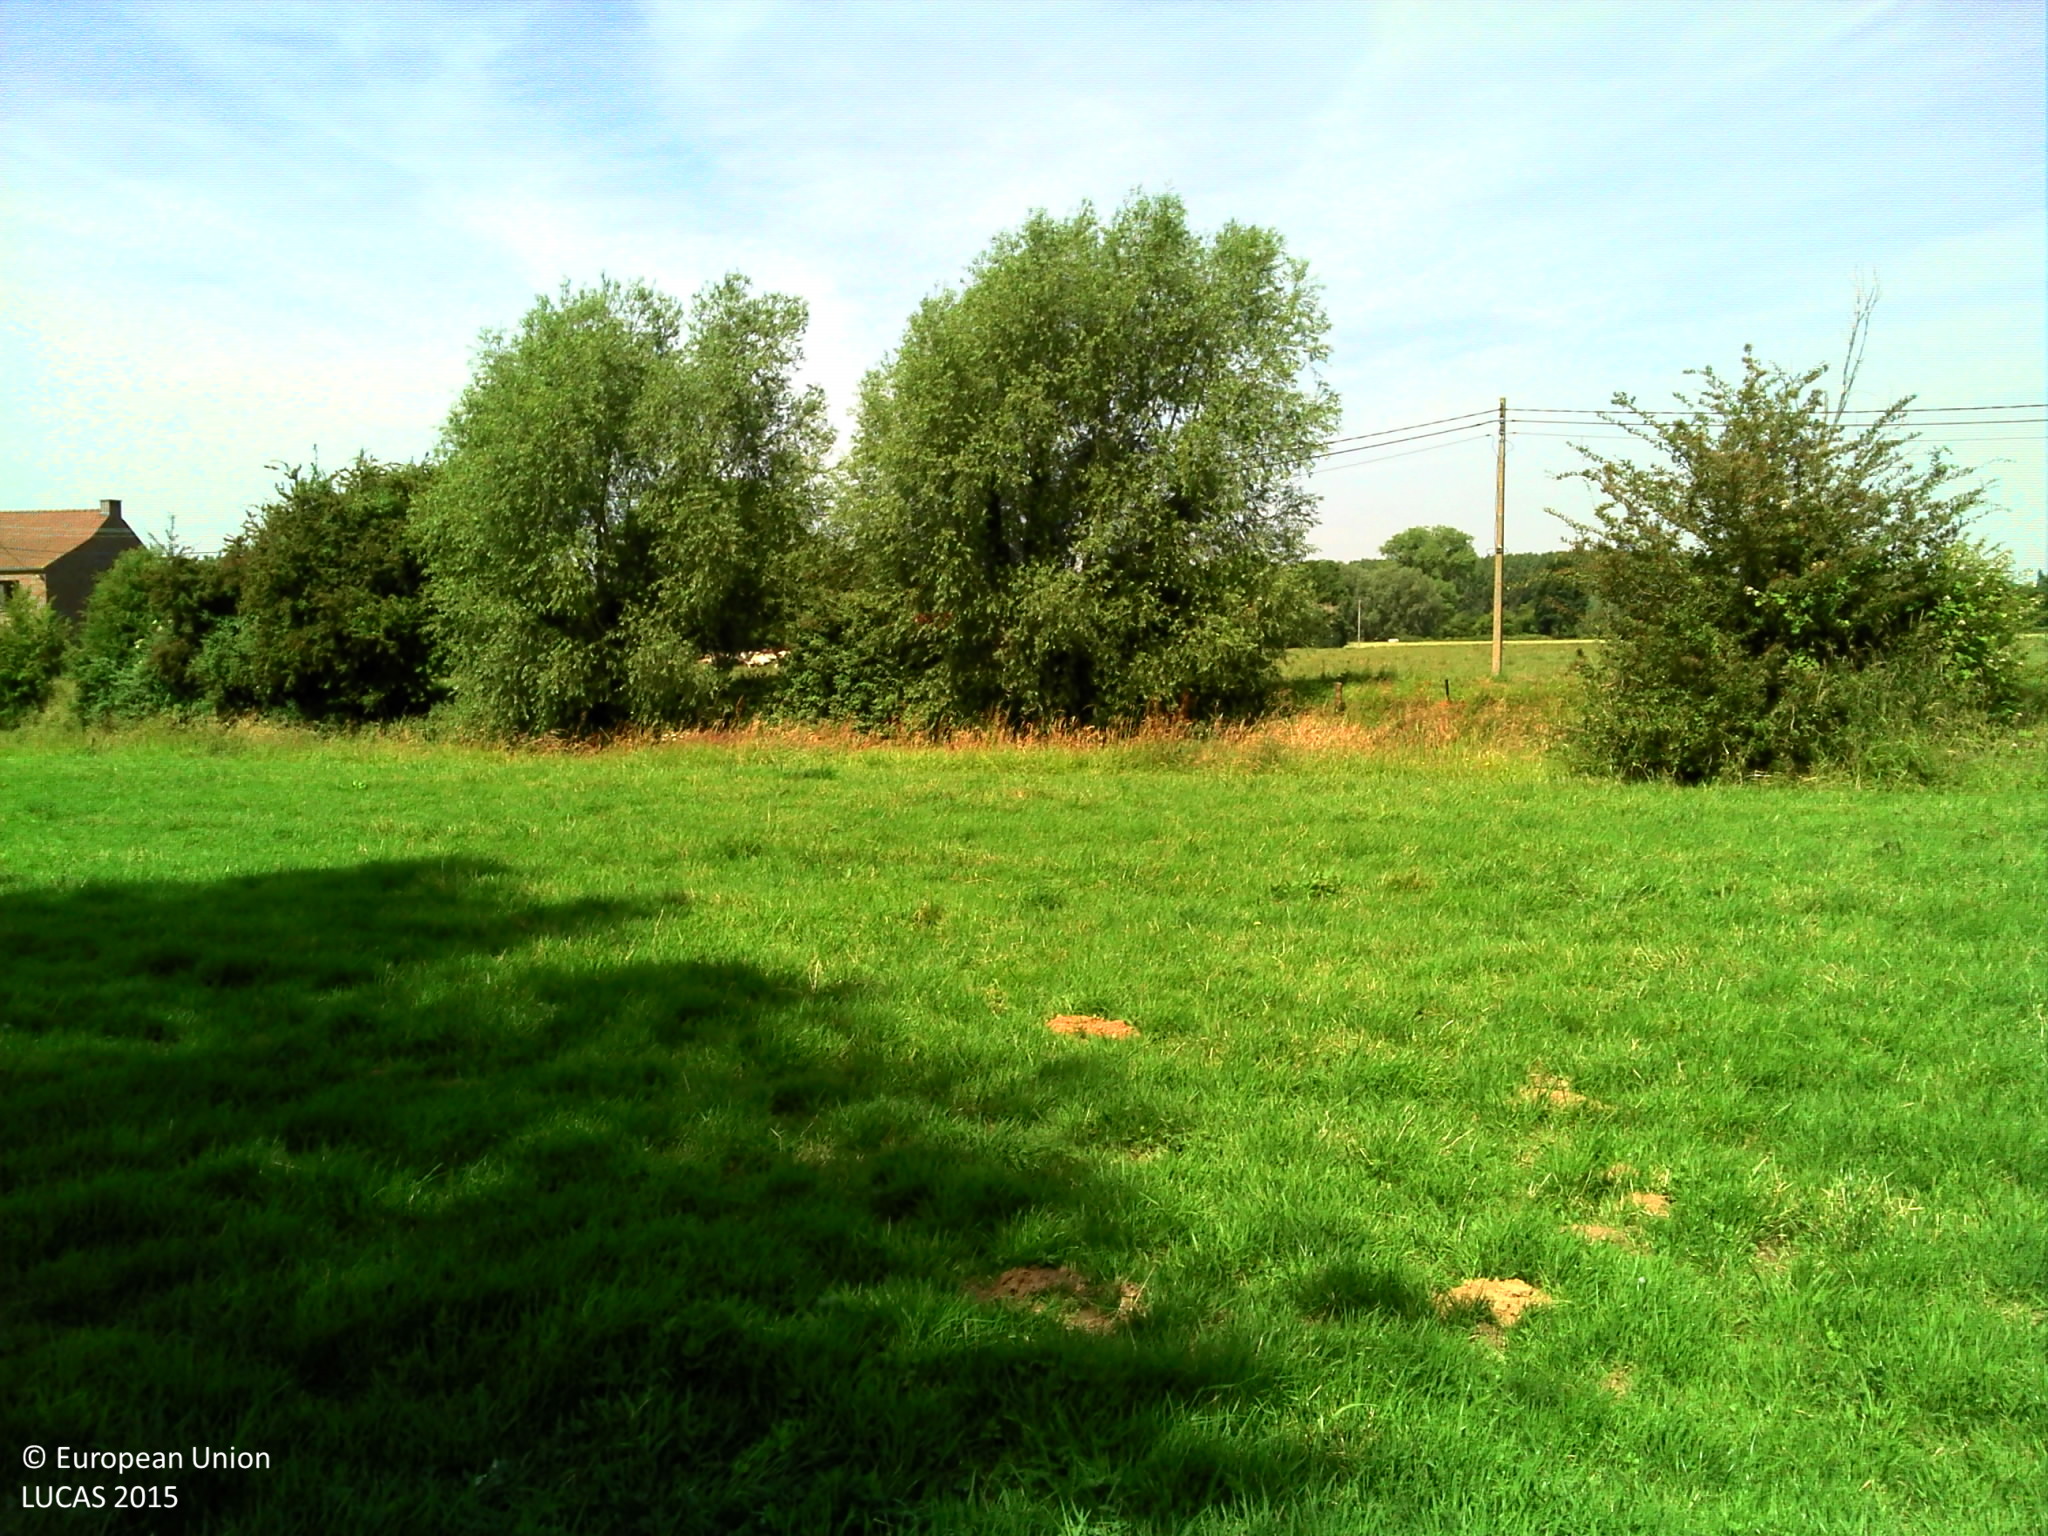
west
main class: Grassland
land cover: Grassland without tree/shrub cover
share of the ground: > 75 %
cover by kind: herbaceous plants 100 %
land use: Agriculture (excluding fallow land and kitchen gardens)
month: June
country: BE
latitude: 50.5456
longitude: 3.6000
